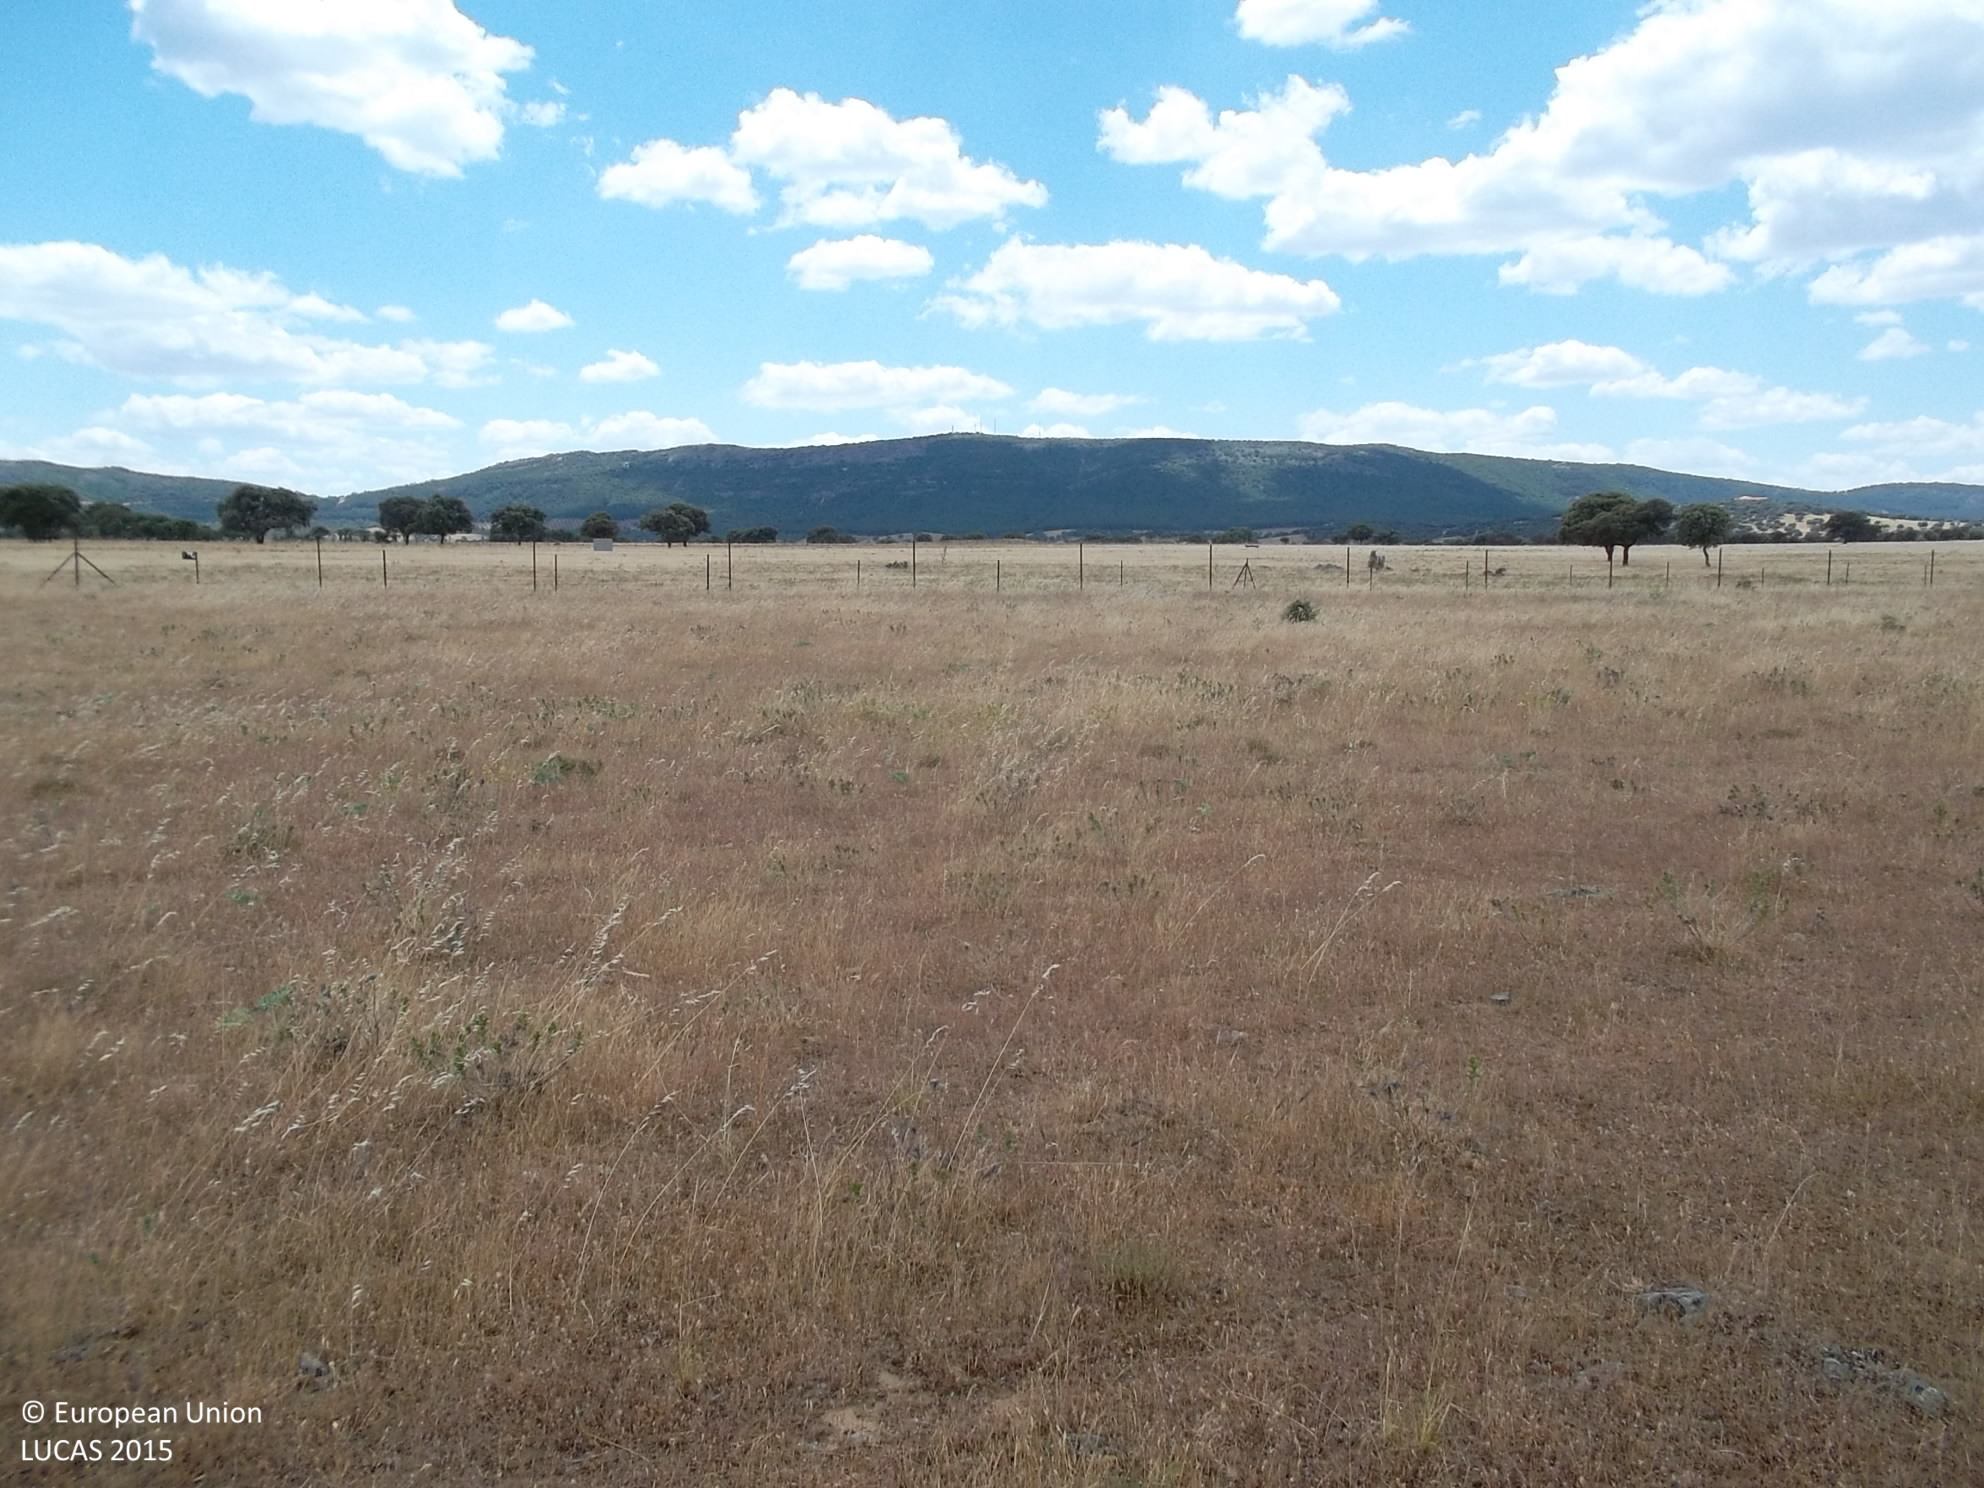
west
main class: Grassland
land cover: Grassland without tree/shrub cover
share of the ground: > 75 %
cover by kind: herbaceous plants 100 %
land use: Agriculture (excluding fallow land and kitchen gardens)
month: May
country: ES
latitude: 38.5778
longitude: -4.3801
